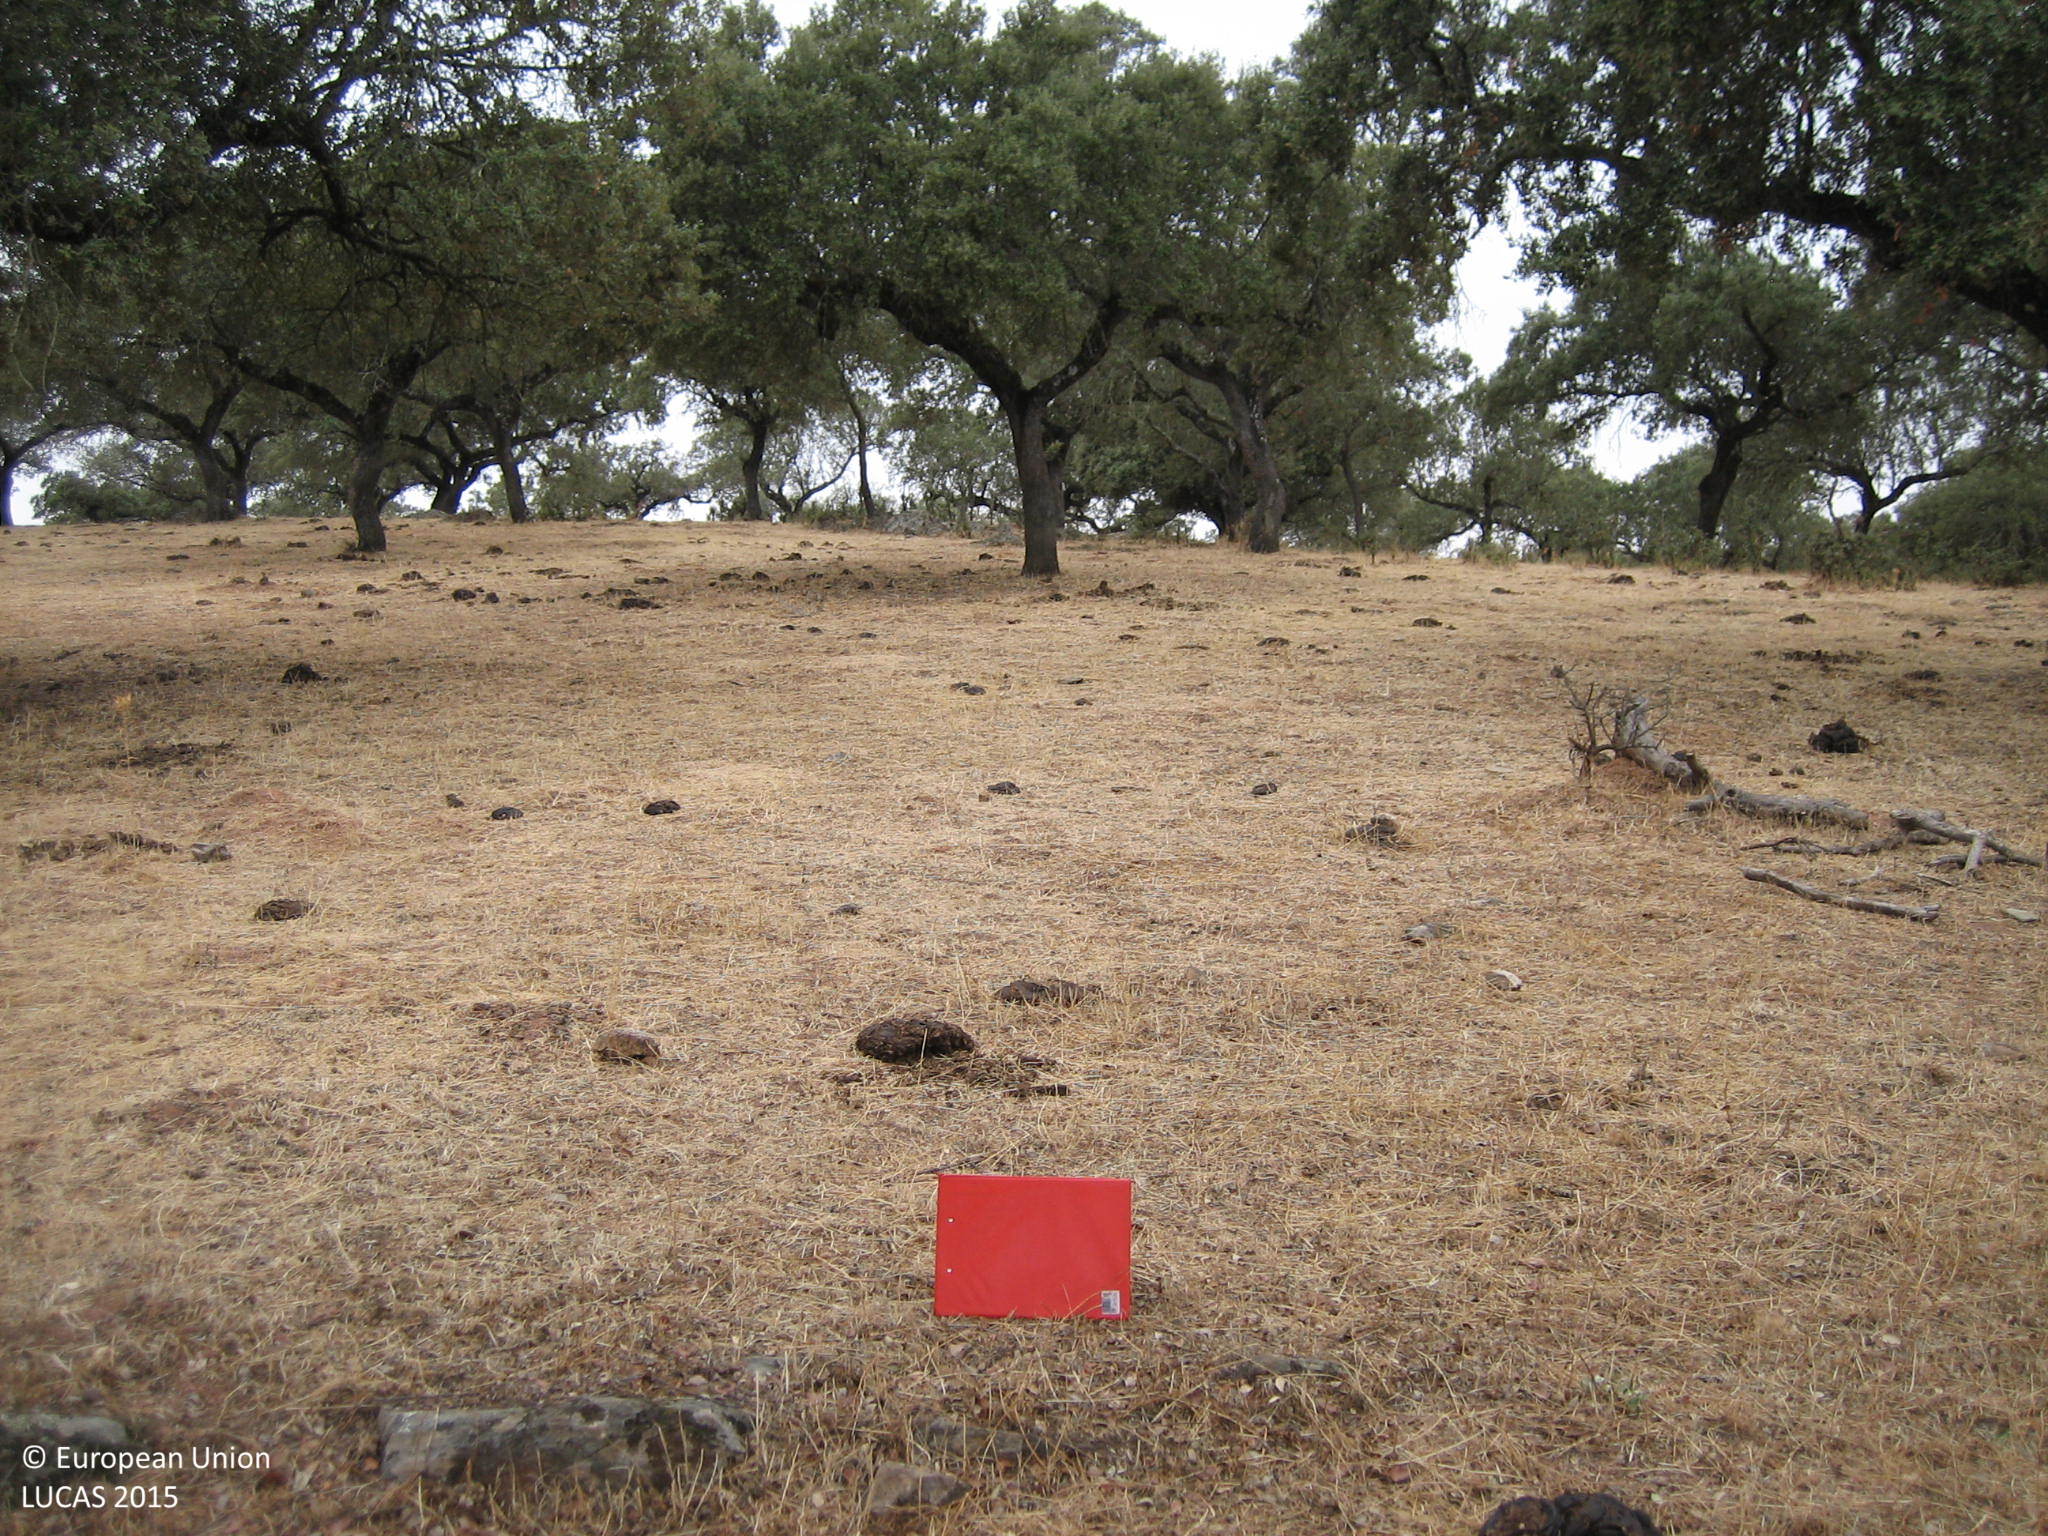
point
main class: Woodland
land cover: Broadleaved woodland
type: broadleaved evergreen forest
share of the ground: 25 - 50 %
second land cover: Grassland without tree/shrub cover
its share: > 75 %
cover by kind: herbaceous plants 60 %, broadleaved forest trees 40 %
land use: Forestry
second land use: Agriculture (excluding fallow land and kitchen gardens)
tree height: > 5 m
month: September
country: ES
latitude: 38.3177
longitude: -7.1626
